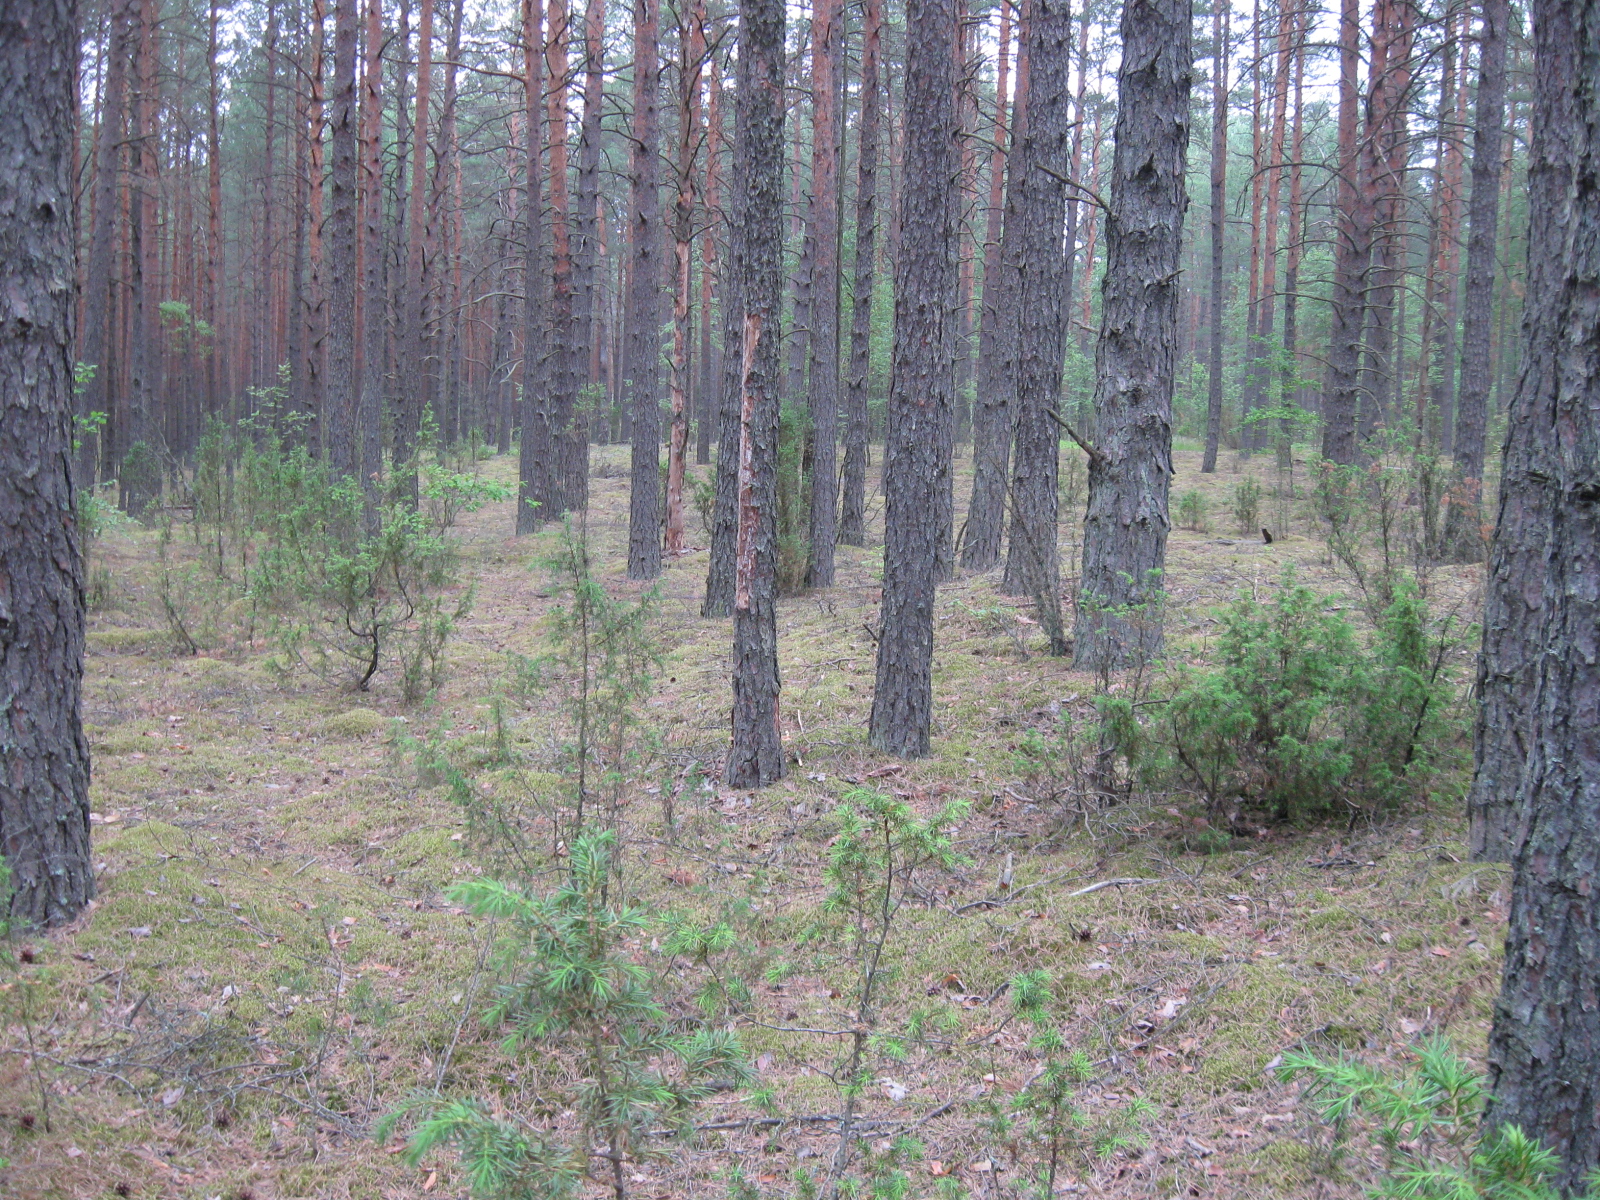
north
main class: Woodland
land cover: Pine dominated coniferous woodland
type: hemiboreal forest and nemoral coniferous forest and mixed broadleaved-coniferous forest
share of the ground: > 75 %
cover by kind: coniferous forest trees 95 %, lichens and mosses 5 %
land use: Forestry
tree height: > 5 m
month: July
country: LT
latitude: 54.1388
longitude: 24.2883
